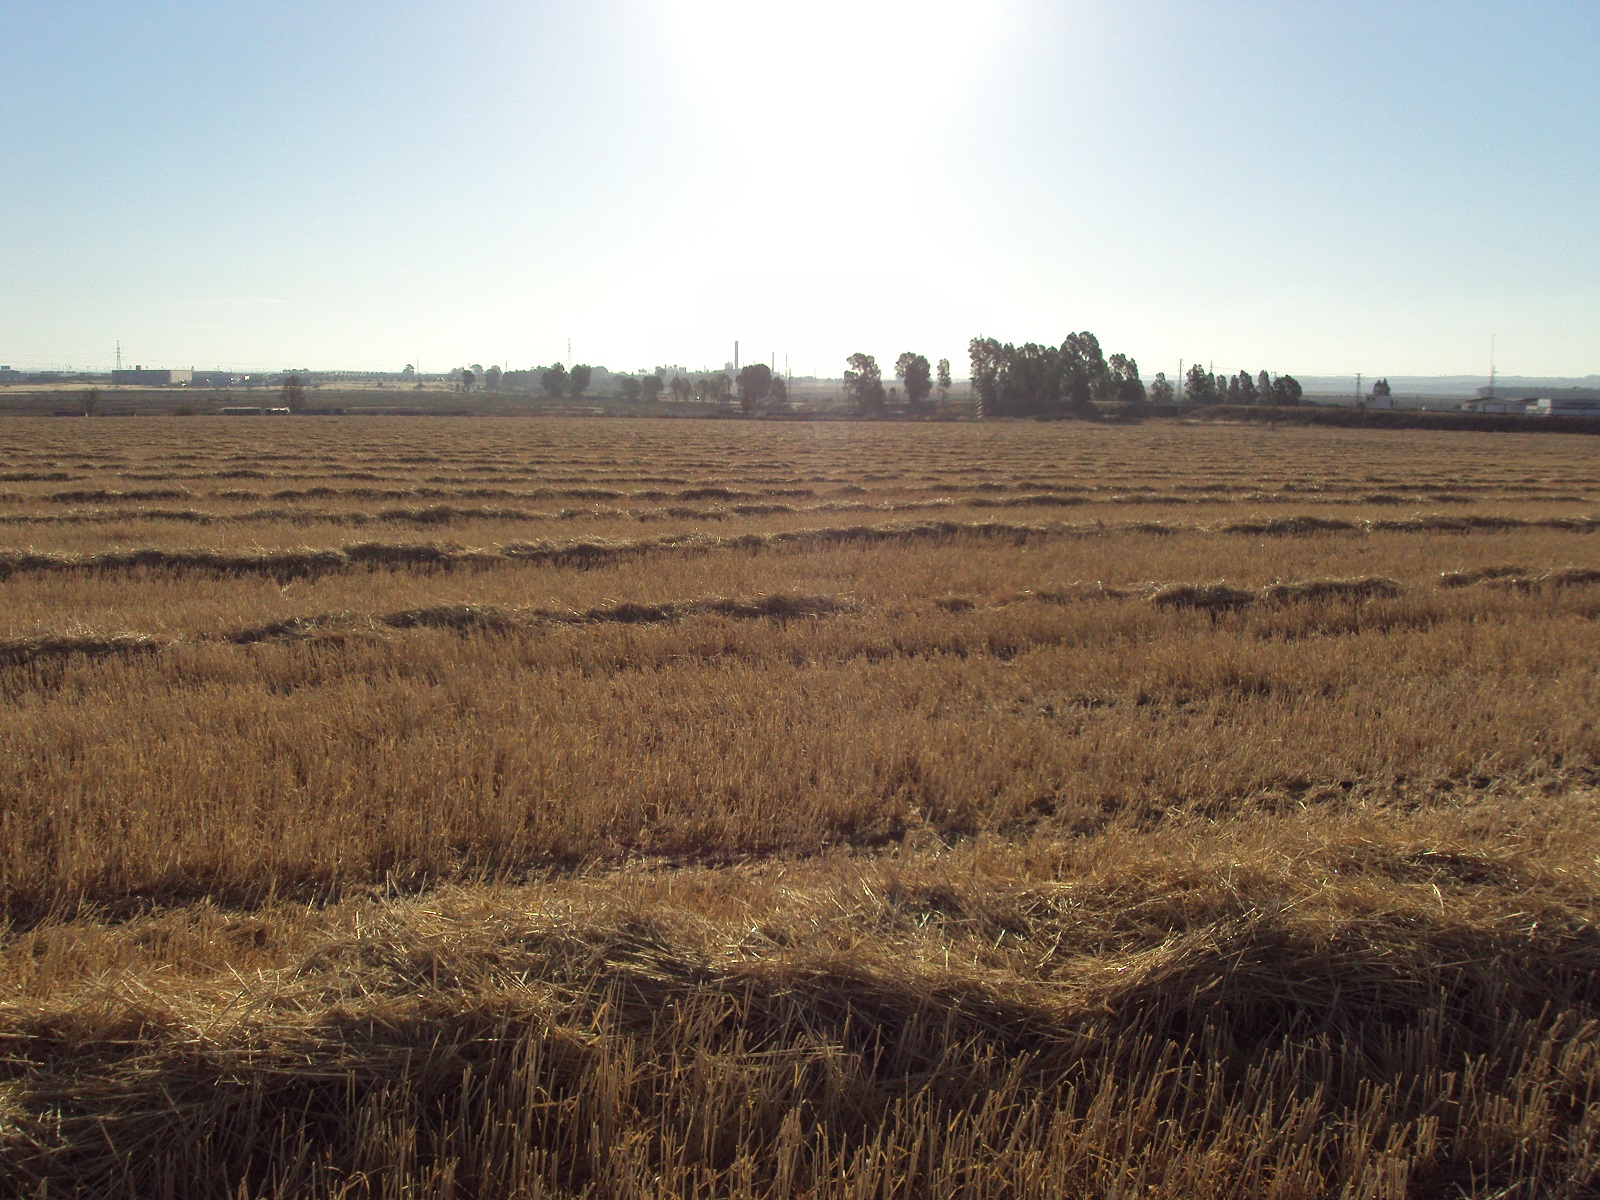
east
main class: Cropland
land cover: Durum wheat
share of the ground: > 75 %
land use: Agriculture (excluding fallow land and kitchen gardens)
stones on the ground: < 10 %
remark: Harvested field
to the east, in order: Durum wheat; Electric lines; Durum wheat
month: June
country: ES
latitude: 37.2940
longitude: -6.9026
